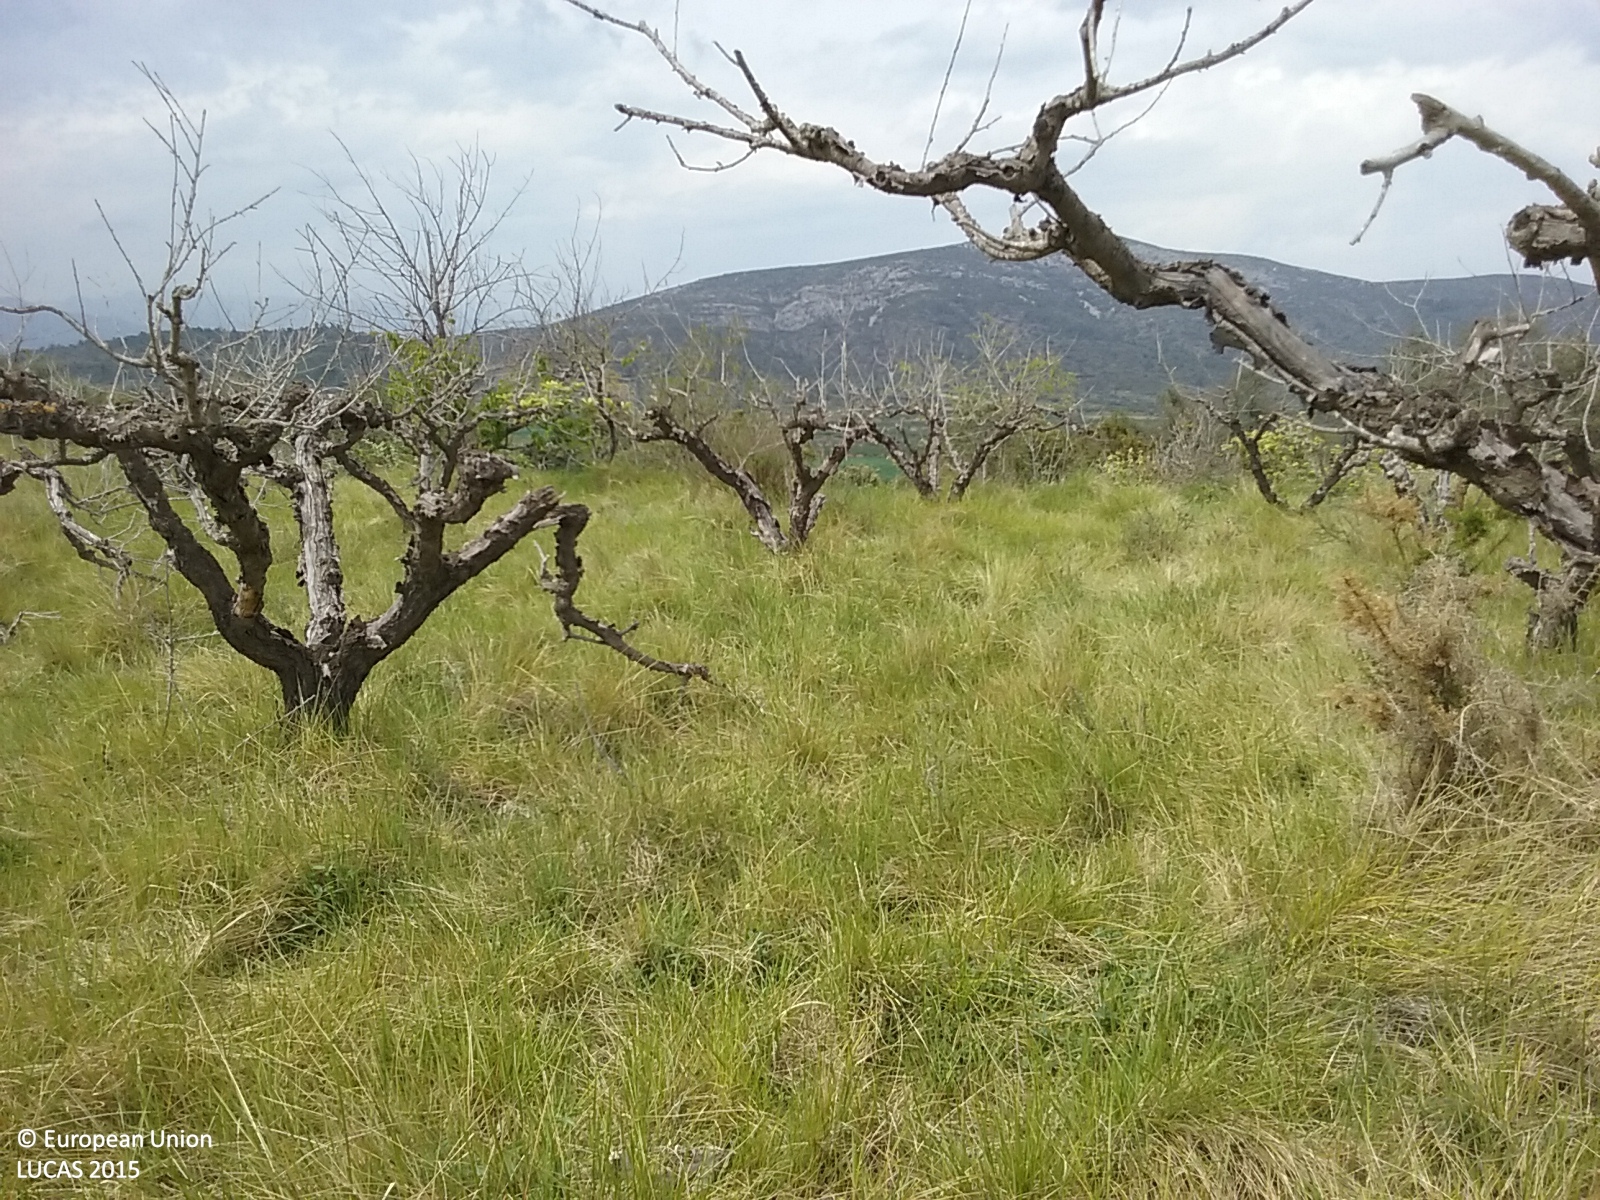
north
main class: Cropland
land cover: Cherry fruit
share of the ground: < 10 %
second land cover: Grassland without tree/shrub cover
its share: > 75 %
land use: Abandoned areas
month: April
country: ES
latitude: 40.5099
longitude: 0.2592
